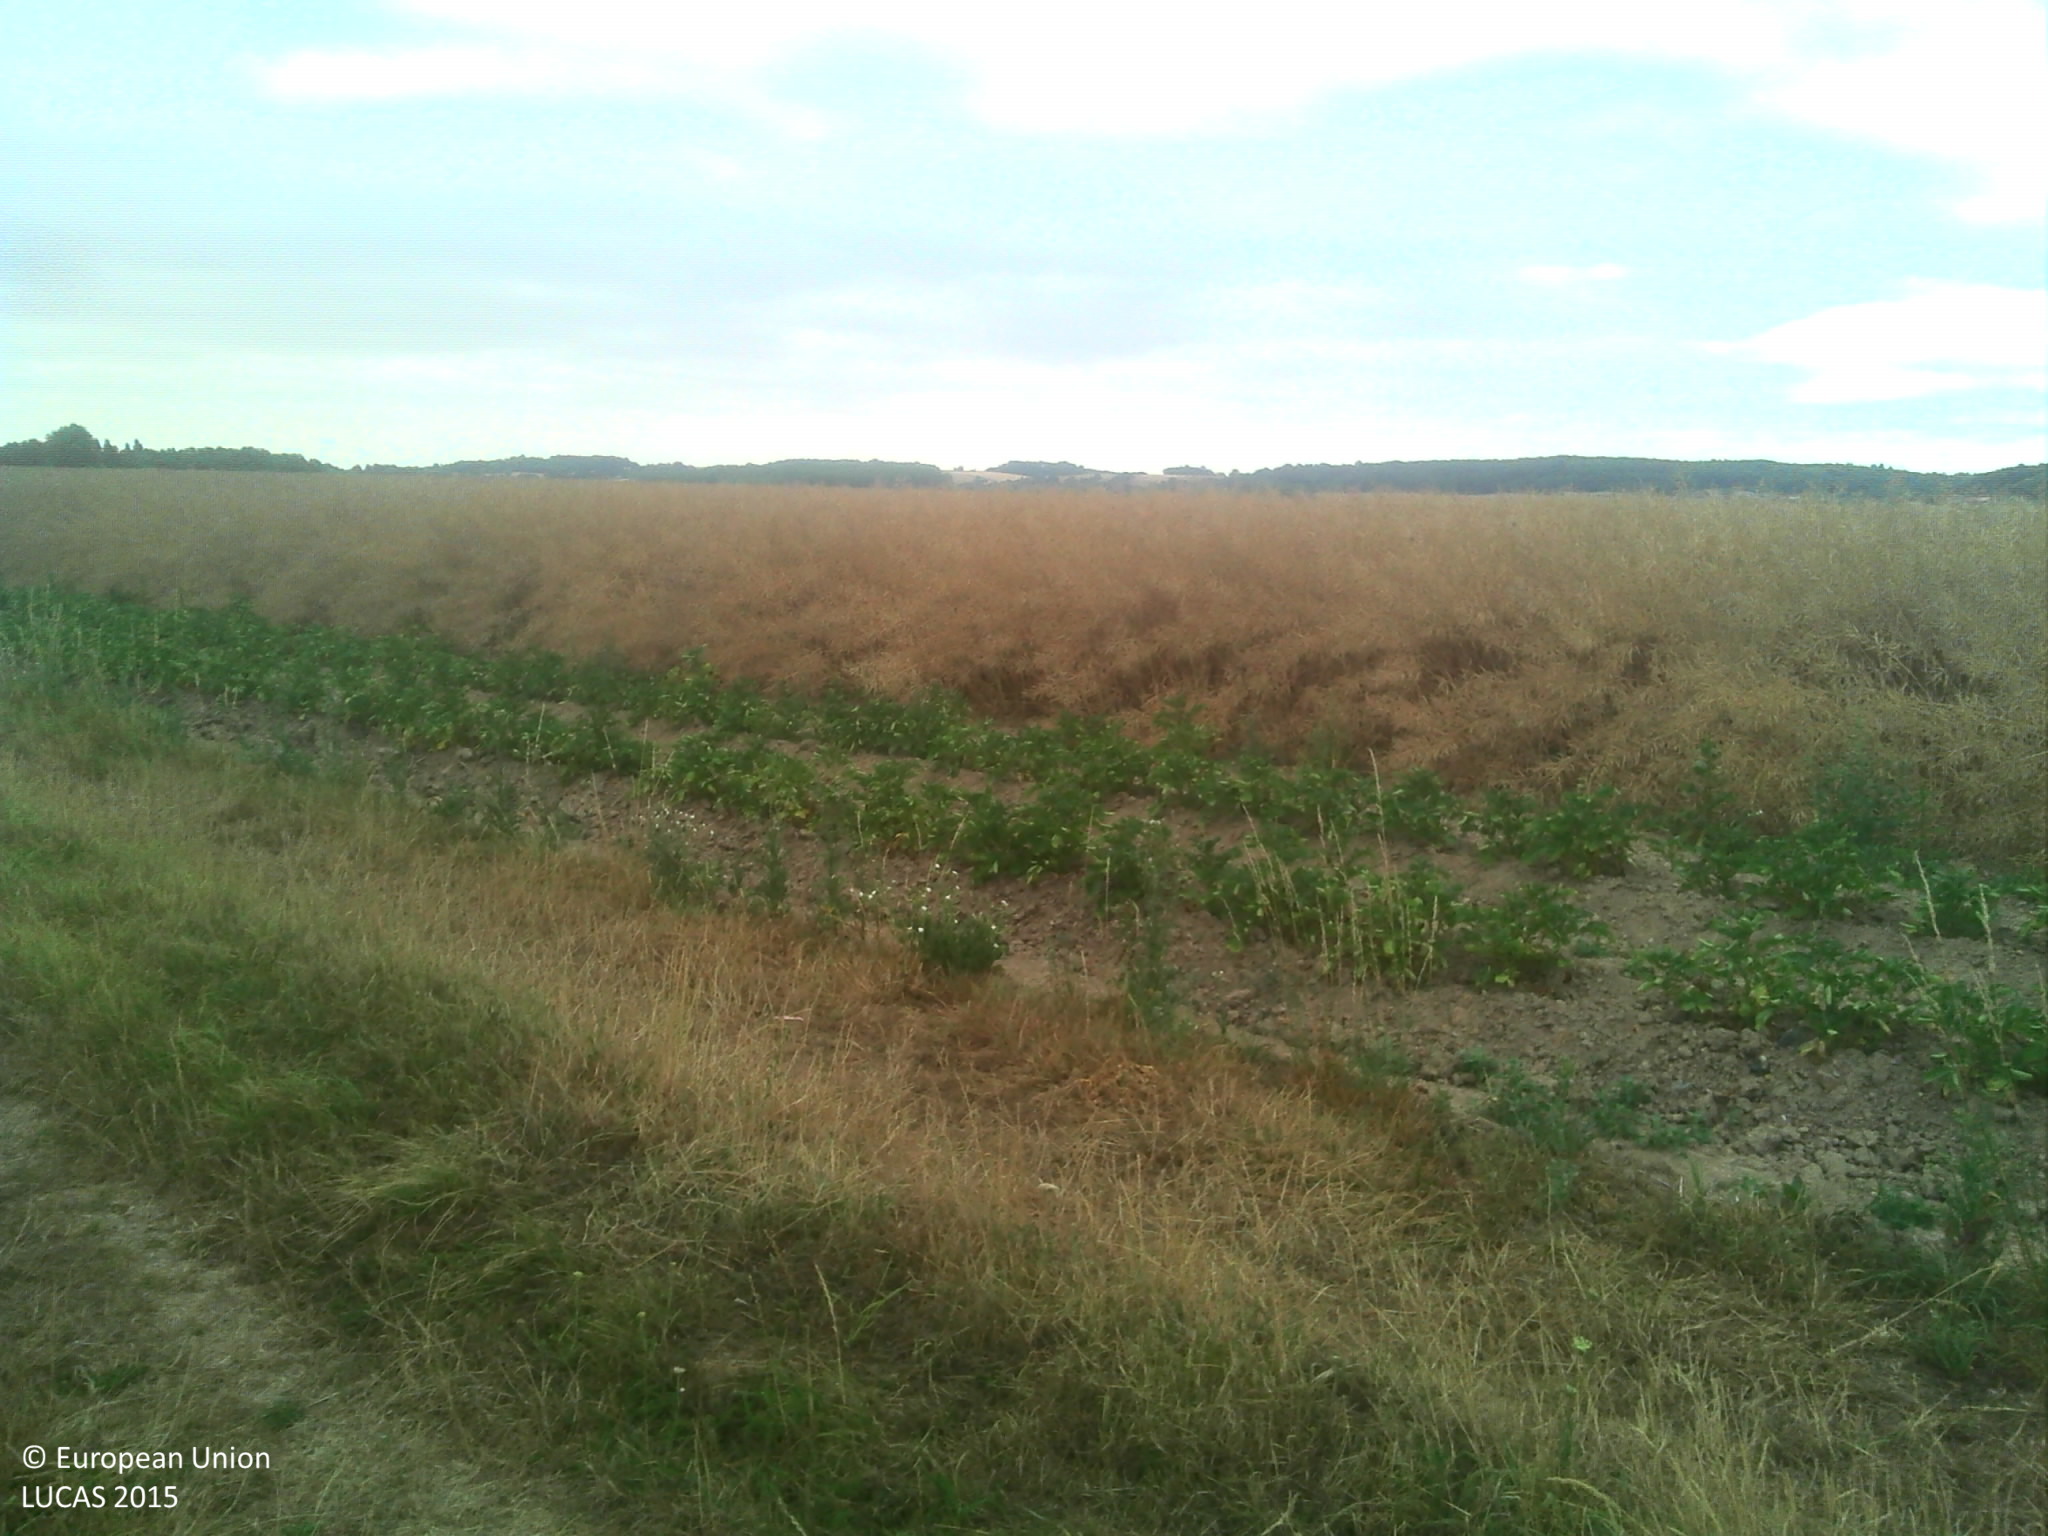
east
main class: Grassland
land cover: Grassland with sparse tree/shrub cover
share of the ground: > 75 %
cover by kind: herbaceous plants 95 %, broadleaved forest trees 5 %
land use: Agriculture (excluding fallow land and kitchen gardens)
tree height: > 5 m
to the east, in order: Grassland with sparse tree/shrub cover; Fences; Ditches and canals; Fences; Grassland without tree/shrub cover; Fences; Grassland without tree/shrub cover; Fences; Tracks; Grass margins; Rape and turnip rape
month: July
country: FR
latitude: 47.7579
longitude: 0.7077
